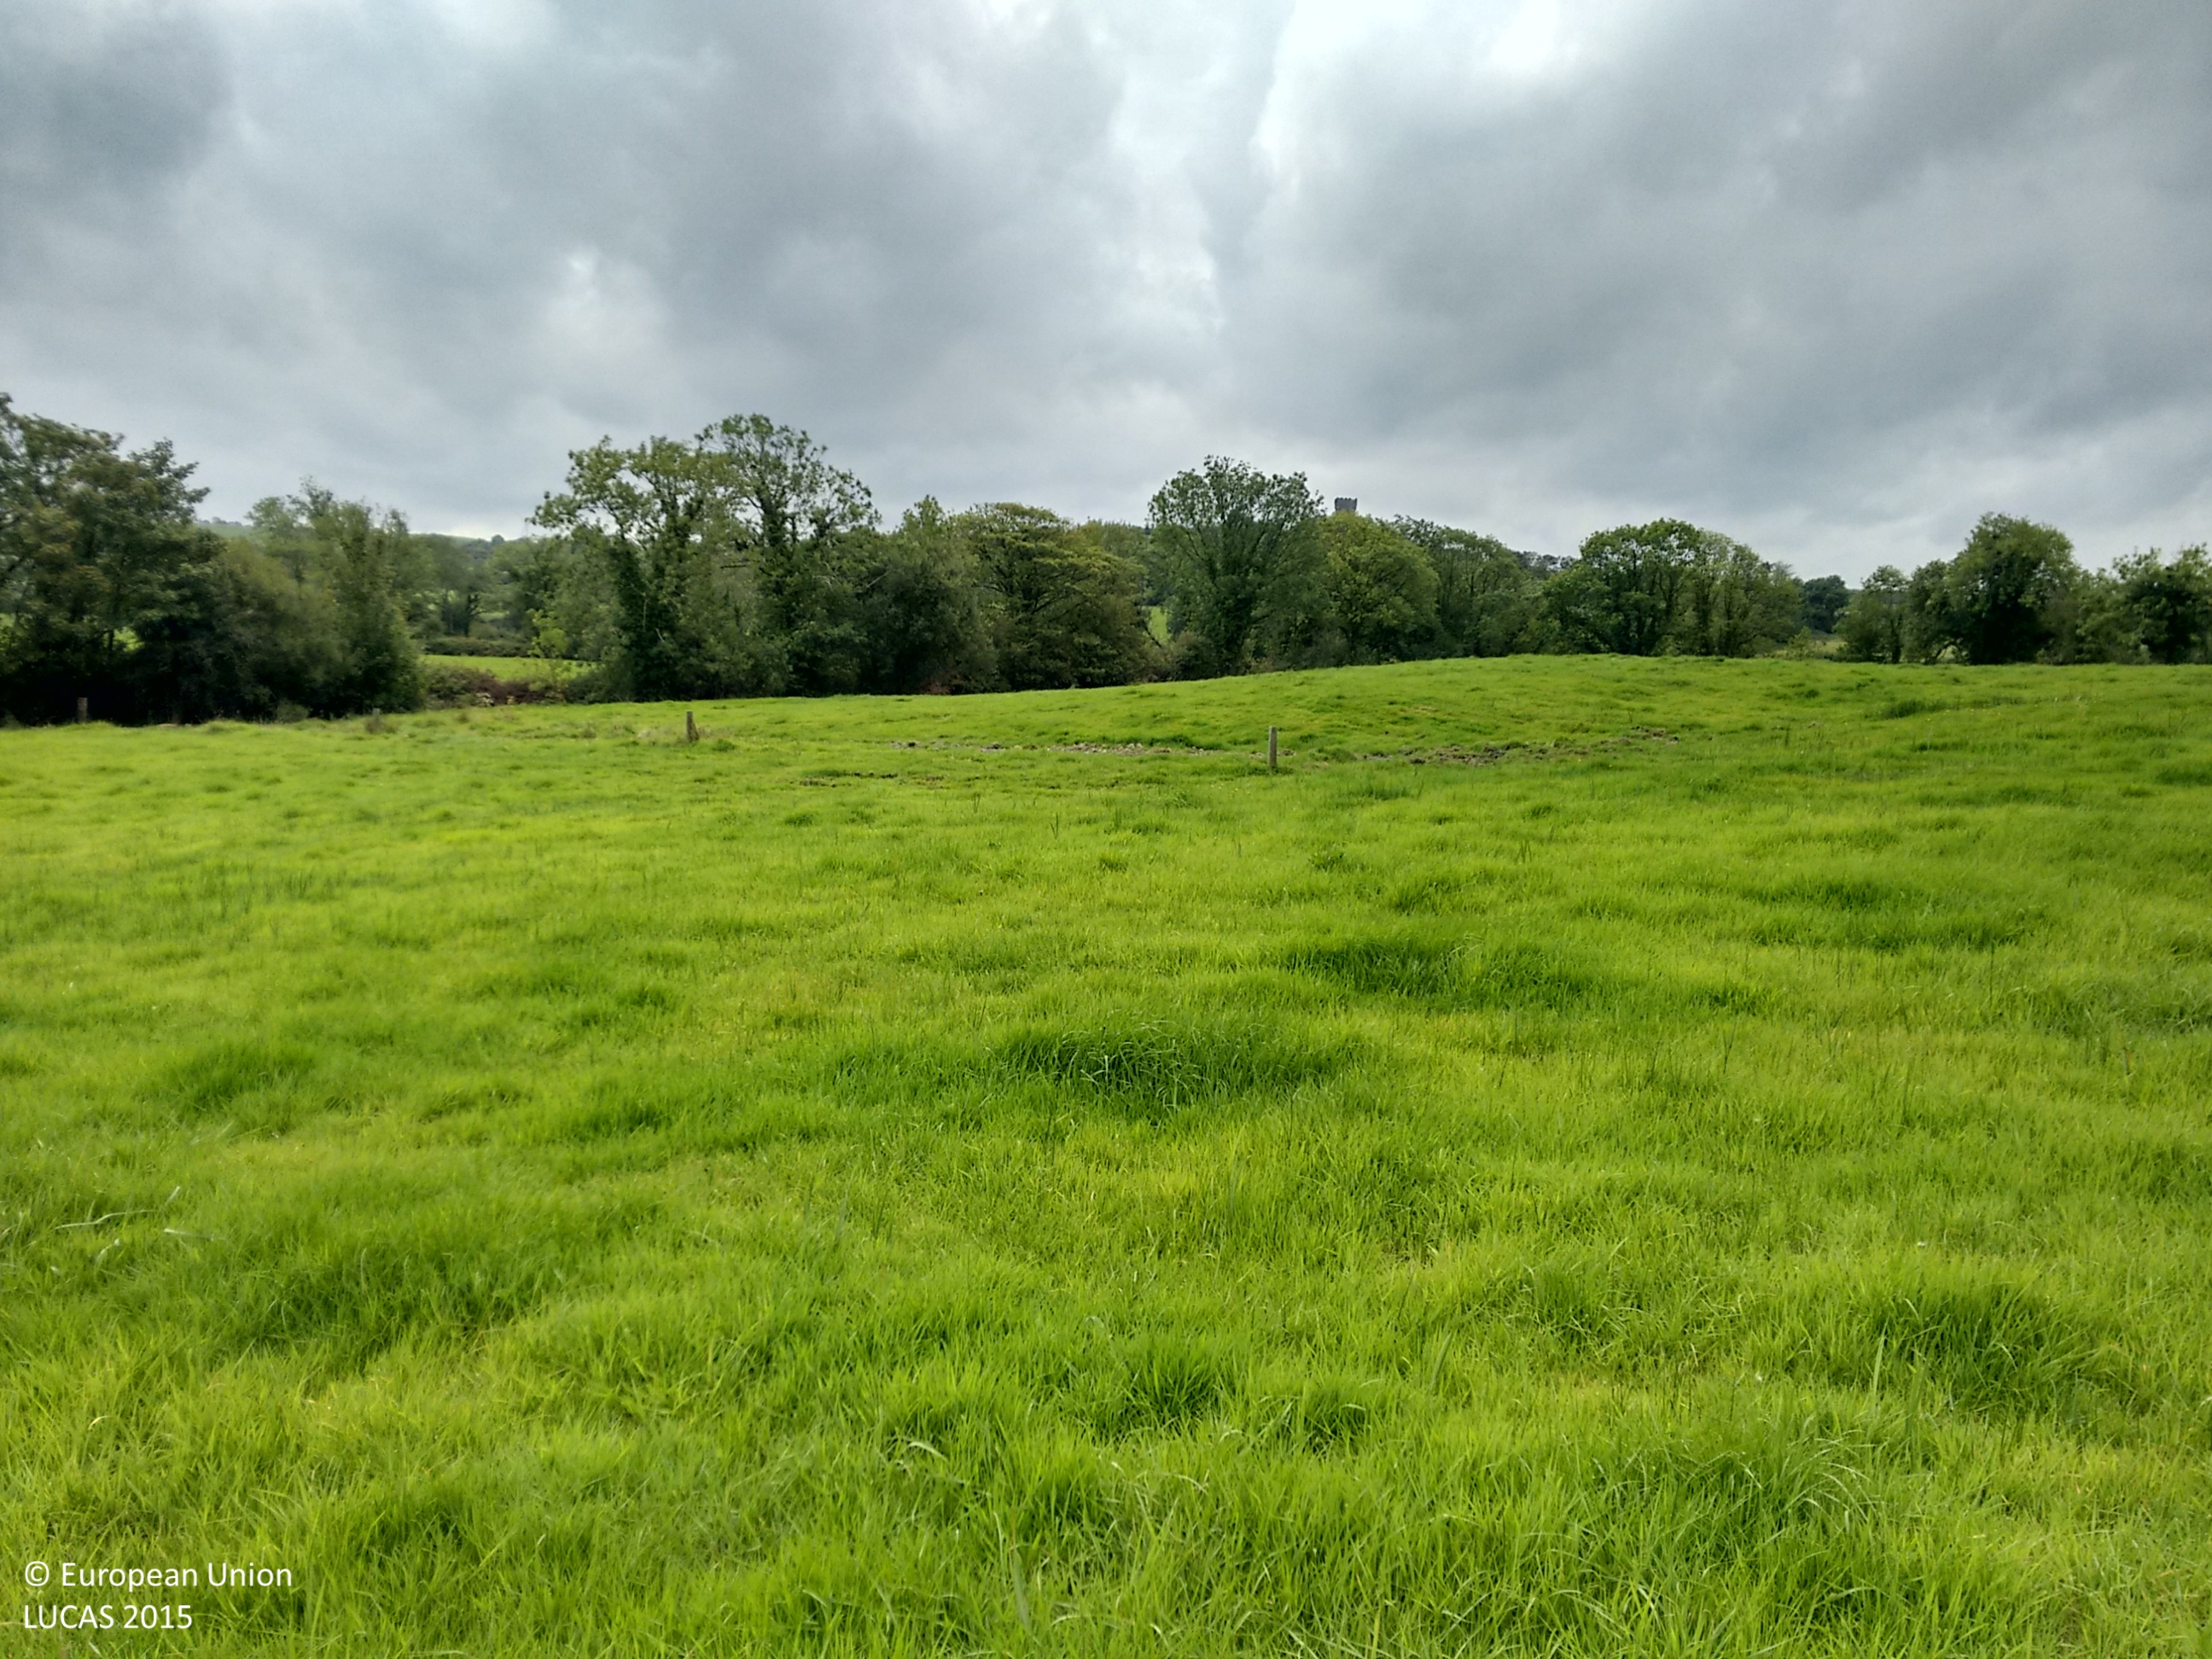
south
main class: Grassland
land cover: Grassland without tree/shrub cover
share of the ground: > 75 %
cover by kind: herbaceous plants 100 %
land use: Agriculture (excluding fallow land and kitchen gardens)
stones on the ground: < 10 %
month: September
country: IE
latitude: 52.5609
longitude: -9.1138
